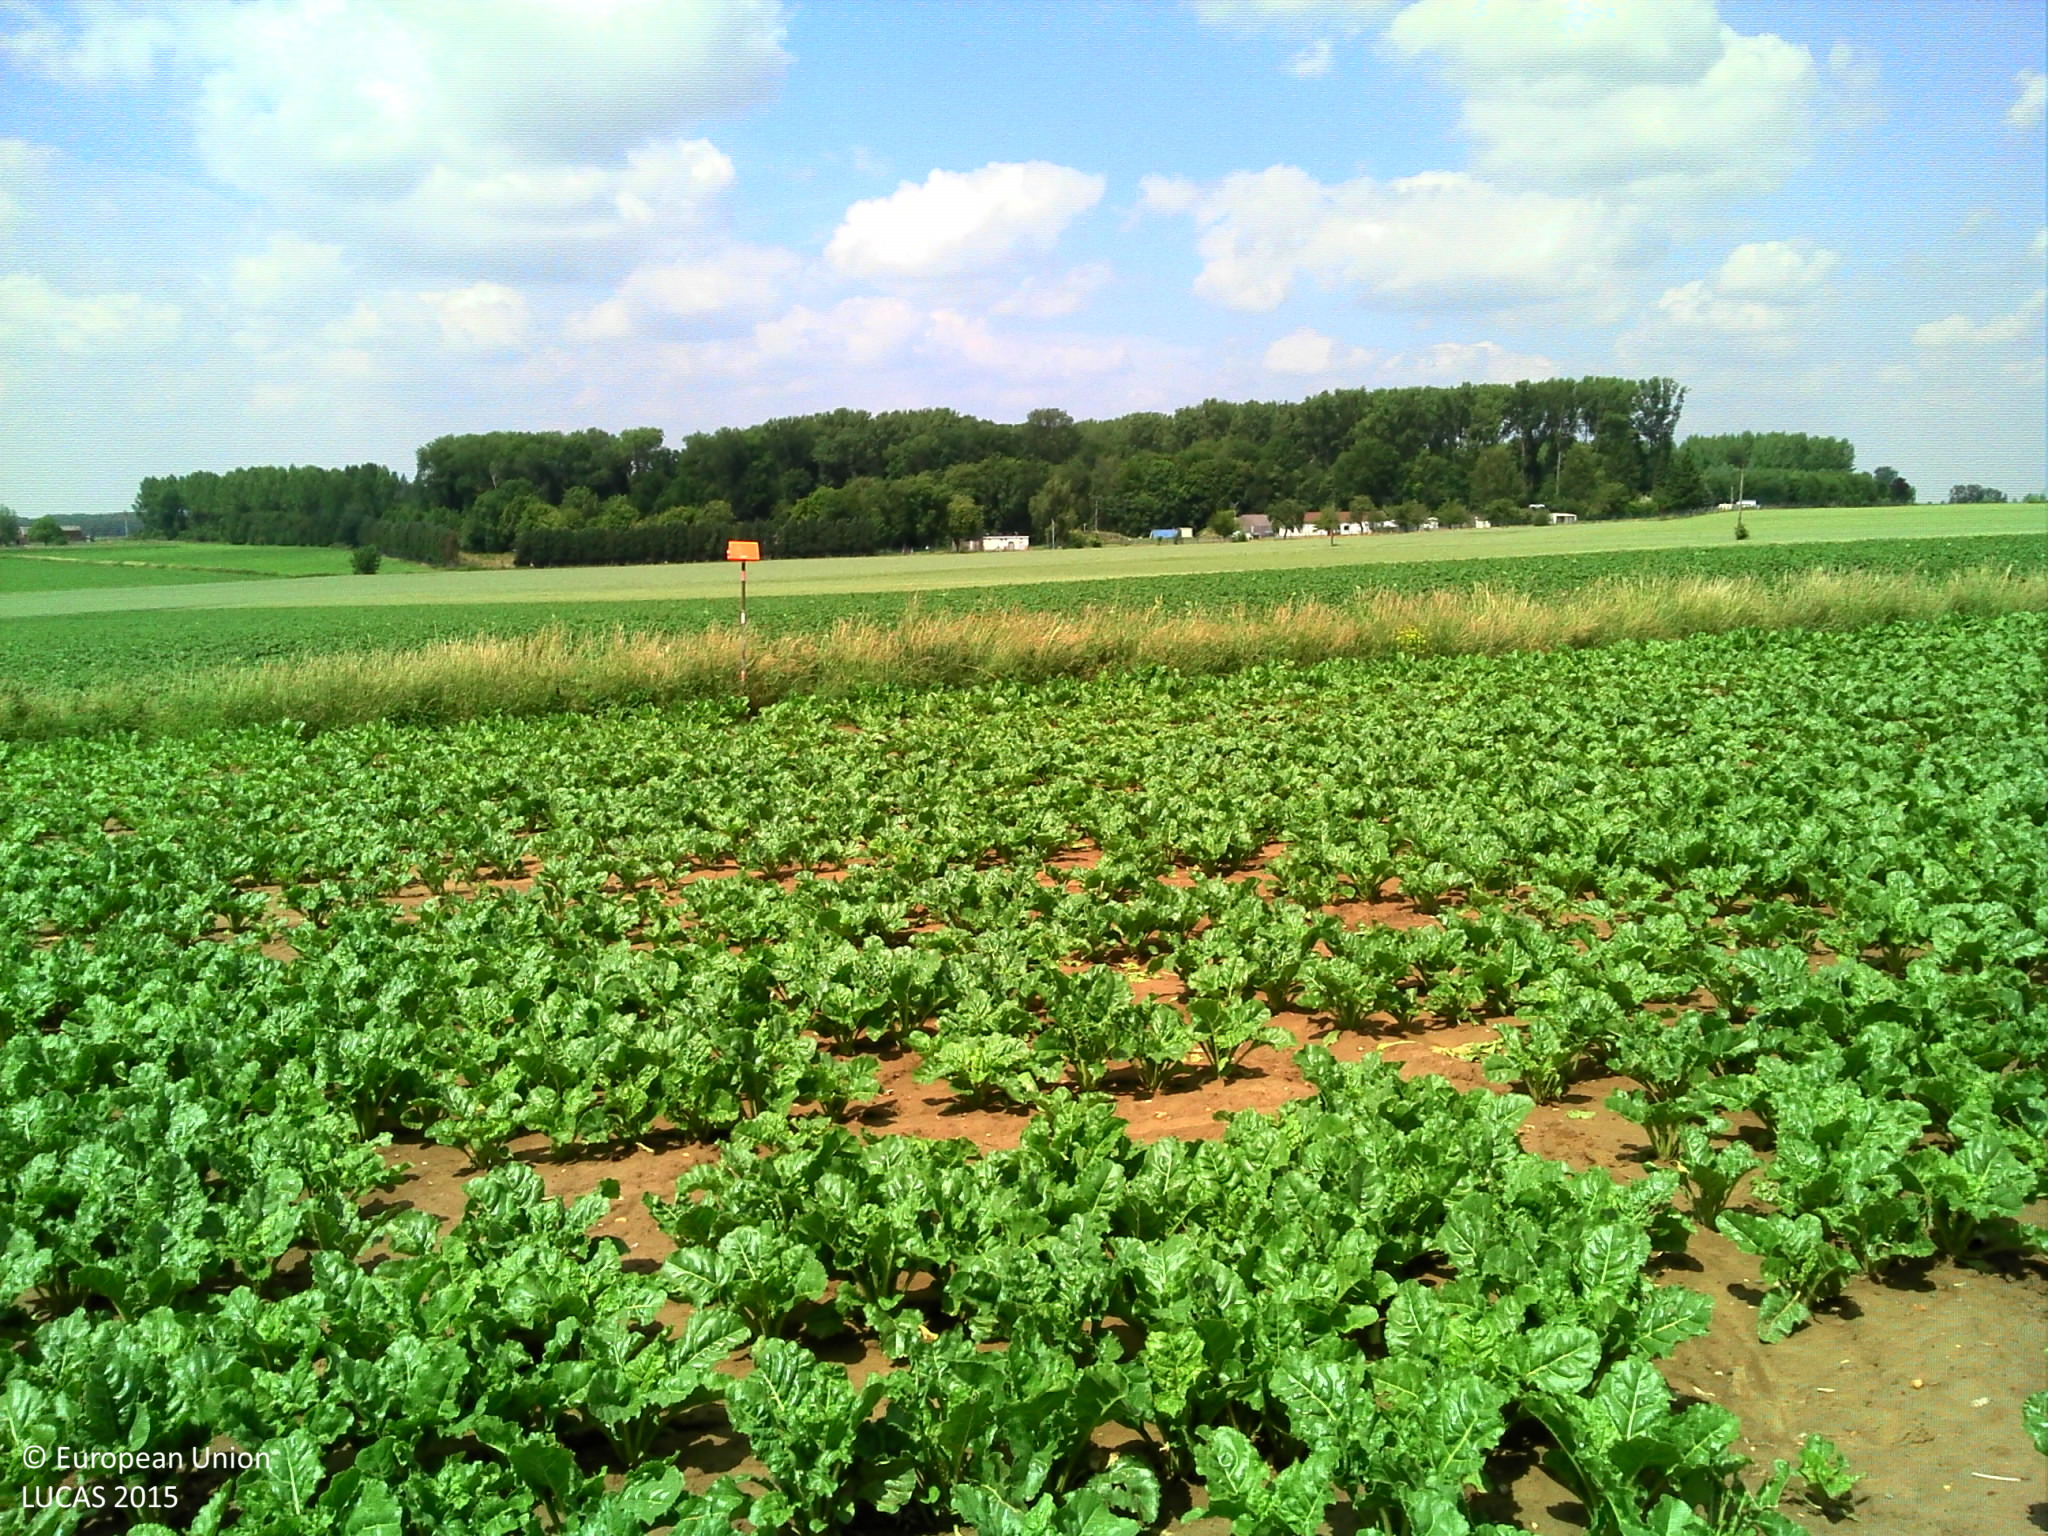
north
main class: Cropland
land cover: Sugar beet
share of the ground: 50 - 75 %
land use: Agriculture (excluding fallow land and kitchen gardens)
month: June
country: BE
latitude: 50.6146
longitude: 3.8743
